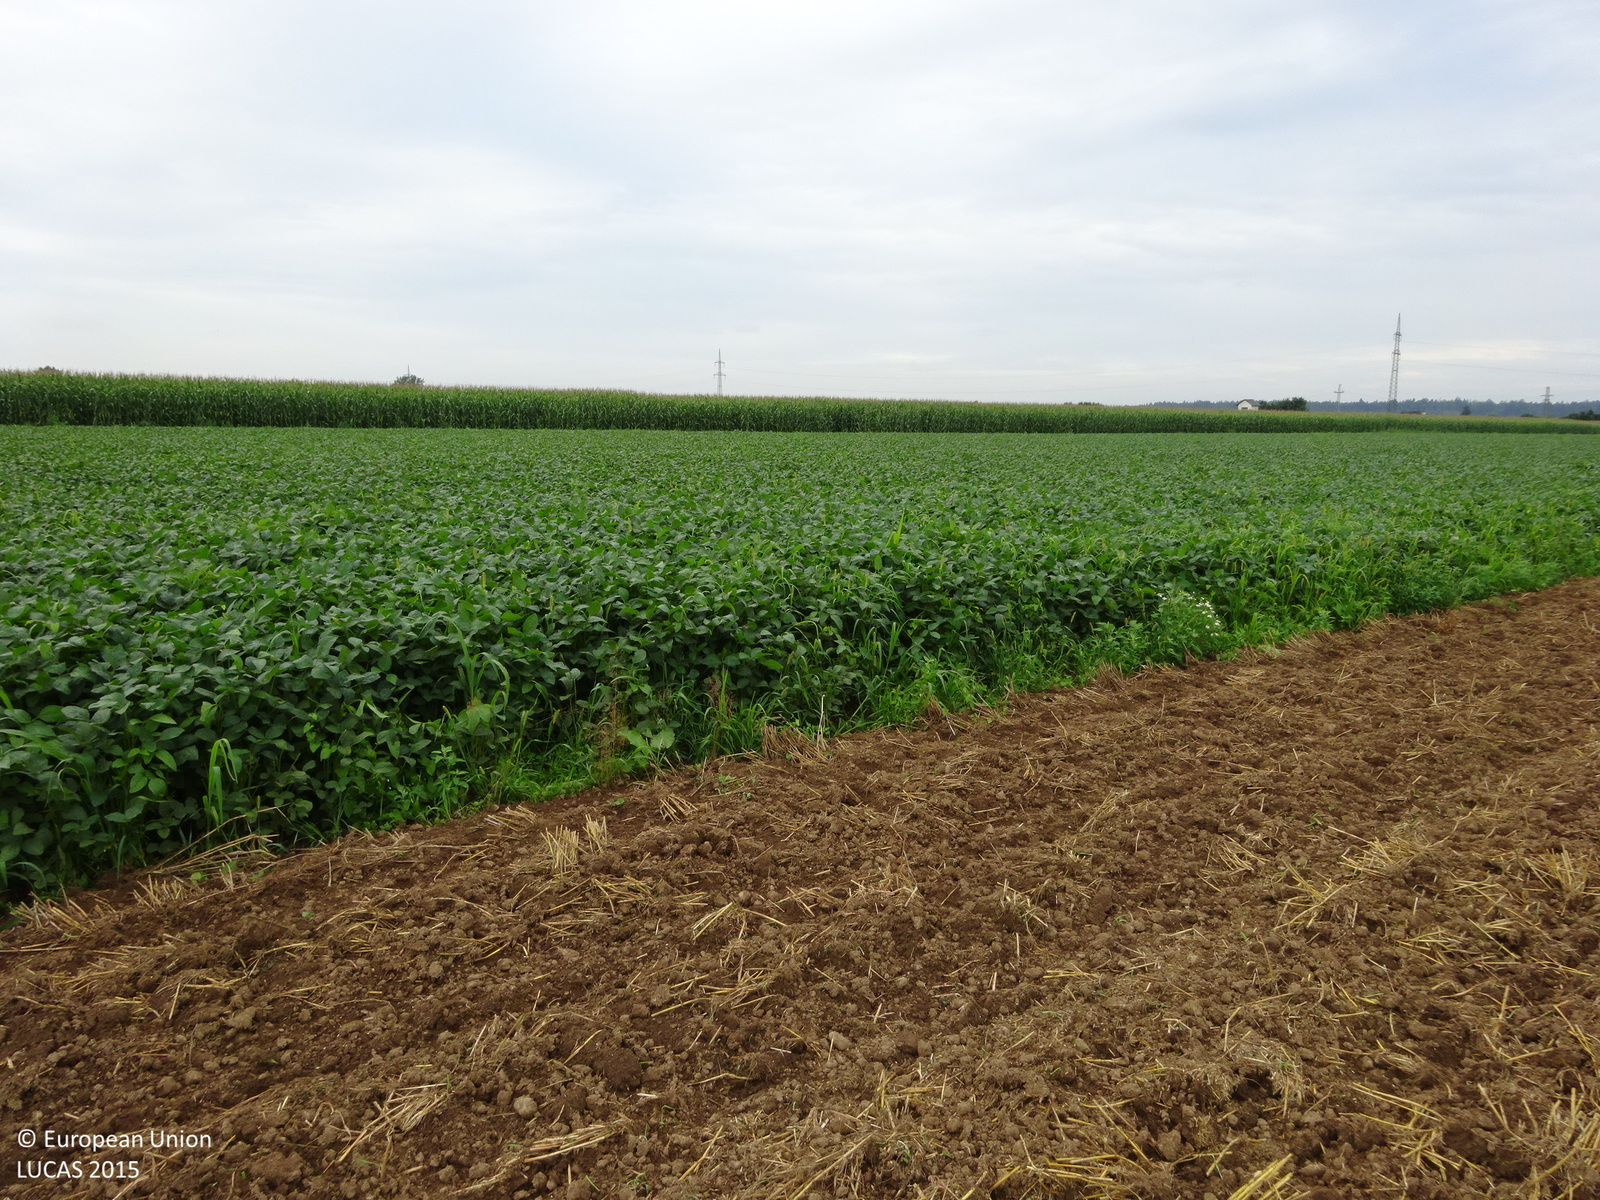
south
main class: Cropland
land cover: Barley
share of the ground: > 75 %
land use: Agriculture (excluding fallow land and kitchen gardens)
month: July
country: AT
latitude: 46.9521
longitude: 15.4525
